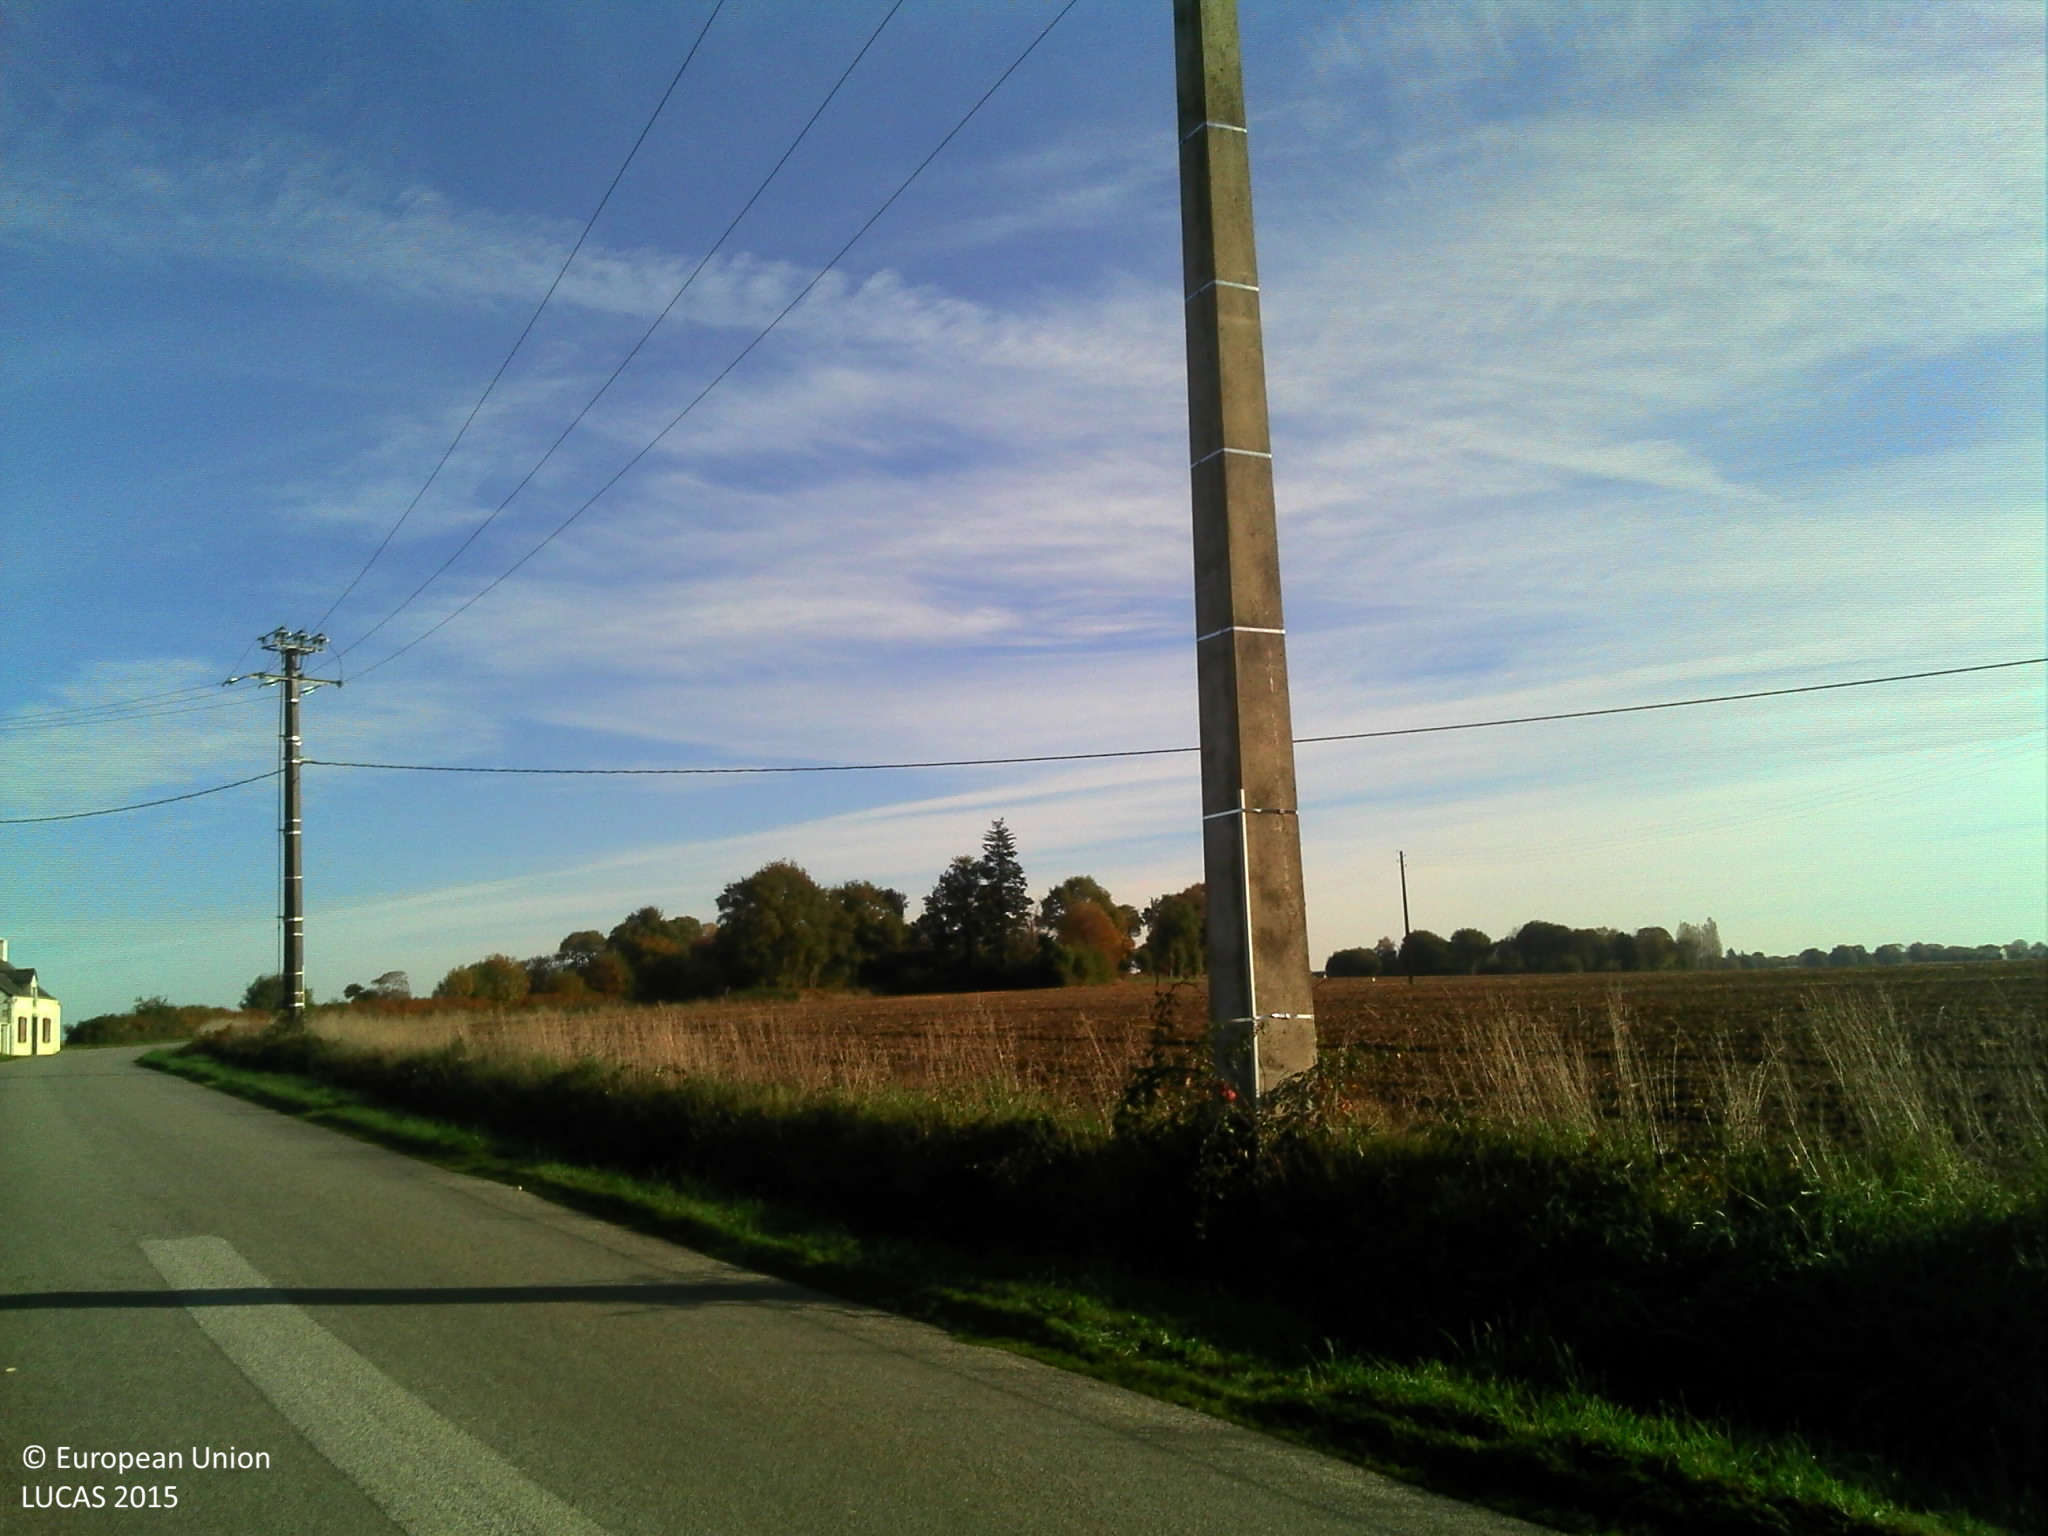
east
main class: Cropland
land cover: Maize
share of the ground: > 75 %
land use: Agriculture (excluding fallow land and kitchen gardens)
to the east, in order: Maize; Grass margins; Ditches and canals; Paved roads, cycling and walking lanes; Grass margins; Ditches and canals; Electric lines; Other bare soil; Electric lines; Other bare soil
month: October
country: FR
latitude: 47.9643
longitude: -2.9648
